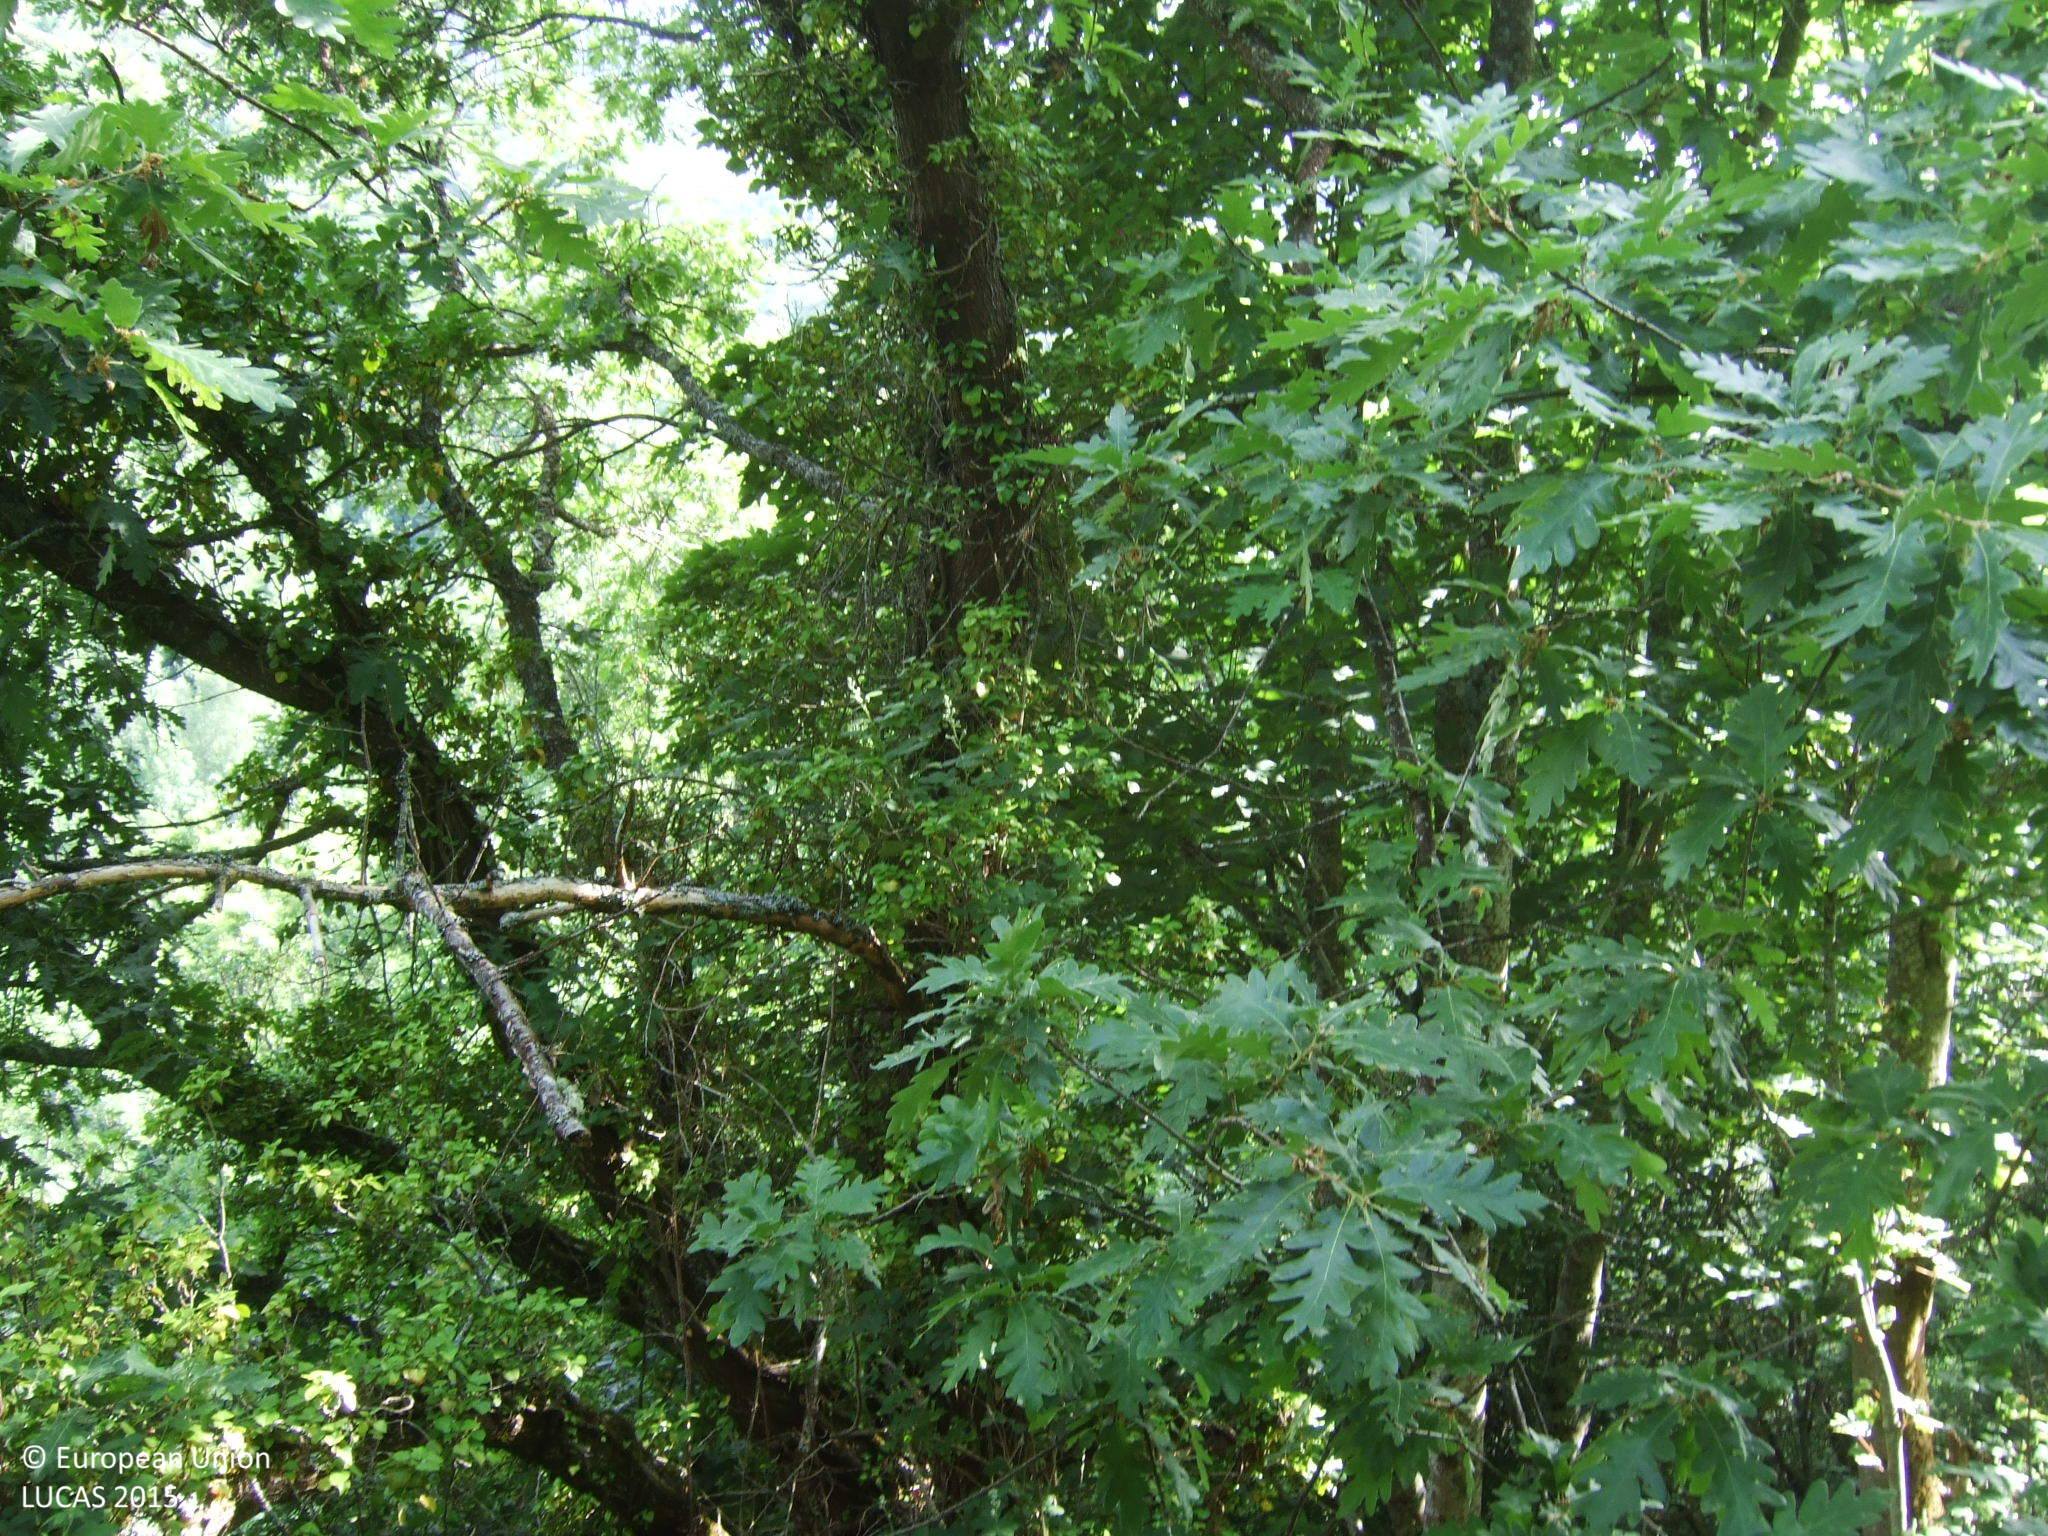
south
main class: Woodland
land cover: Broadleaved woodland
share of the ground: 50 - 75 %
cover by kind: broadleaved forest trees 65 %, shrubs 35 %
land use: Semi-natural and natural areas not in use
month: June
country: ES
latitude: 42.6505
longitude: -7.0507
